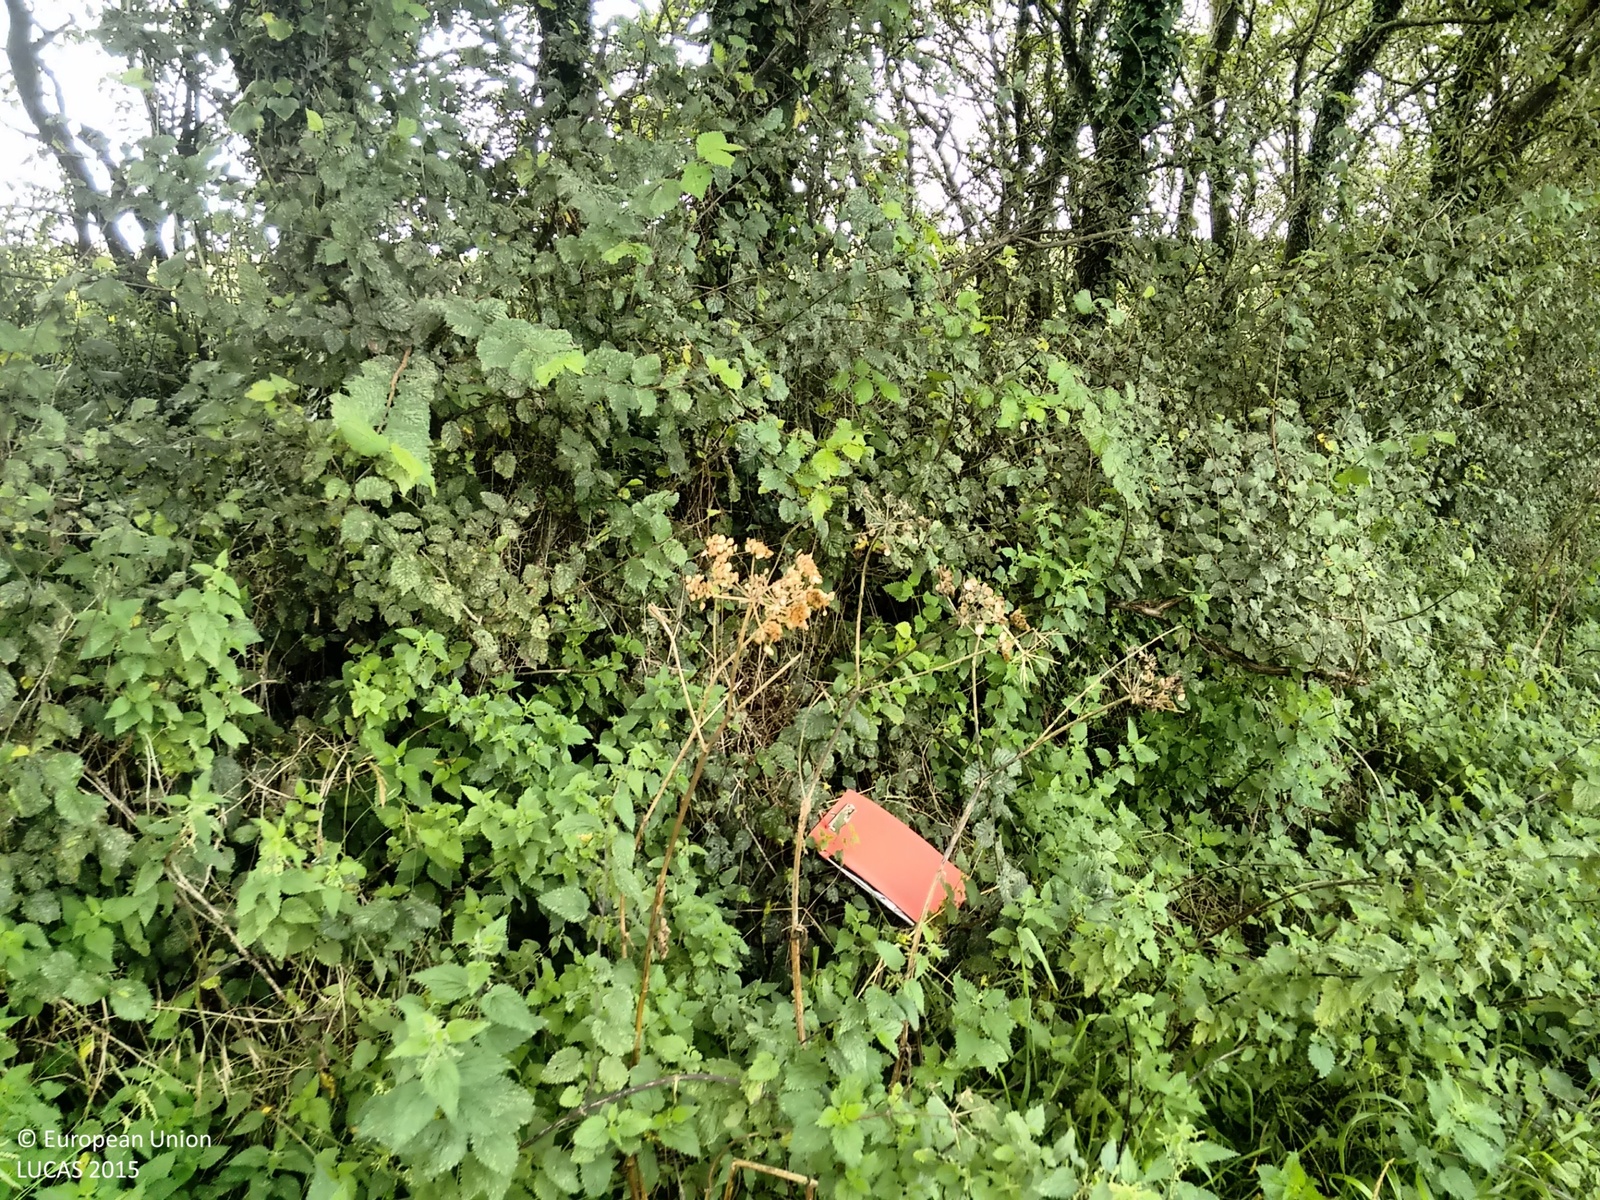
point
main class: Woodland
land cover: Broadleaved woodland
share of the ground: > 75 %
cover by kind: broadleaved forest trees 100 %
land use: Agriculture (excluding fallow land and kitchen gardens)
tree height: > 5 m
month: August
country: GB
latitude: 50.0304
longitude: -5.2395
